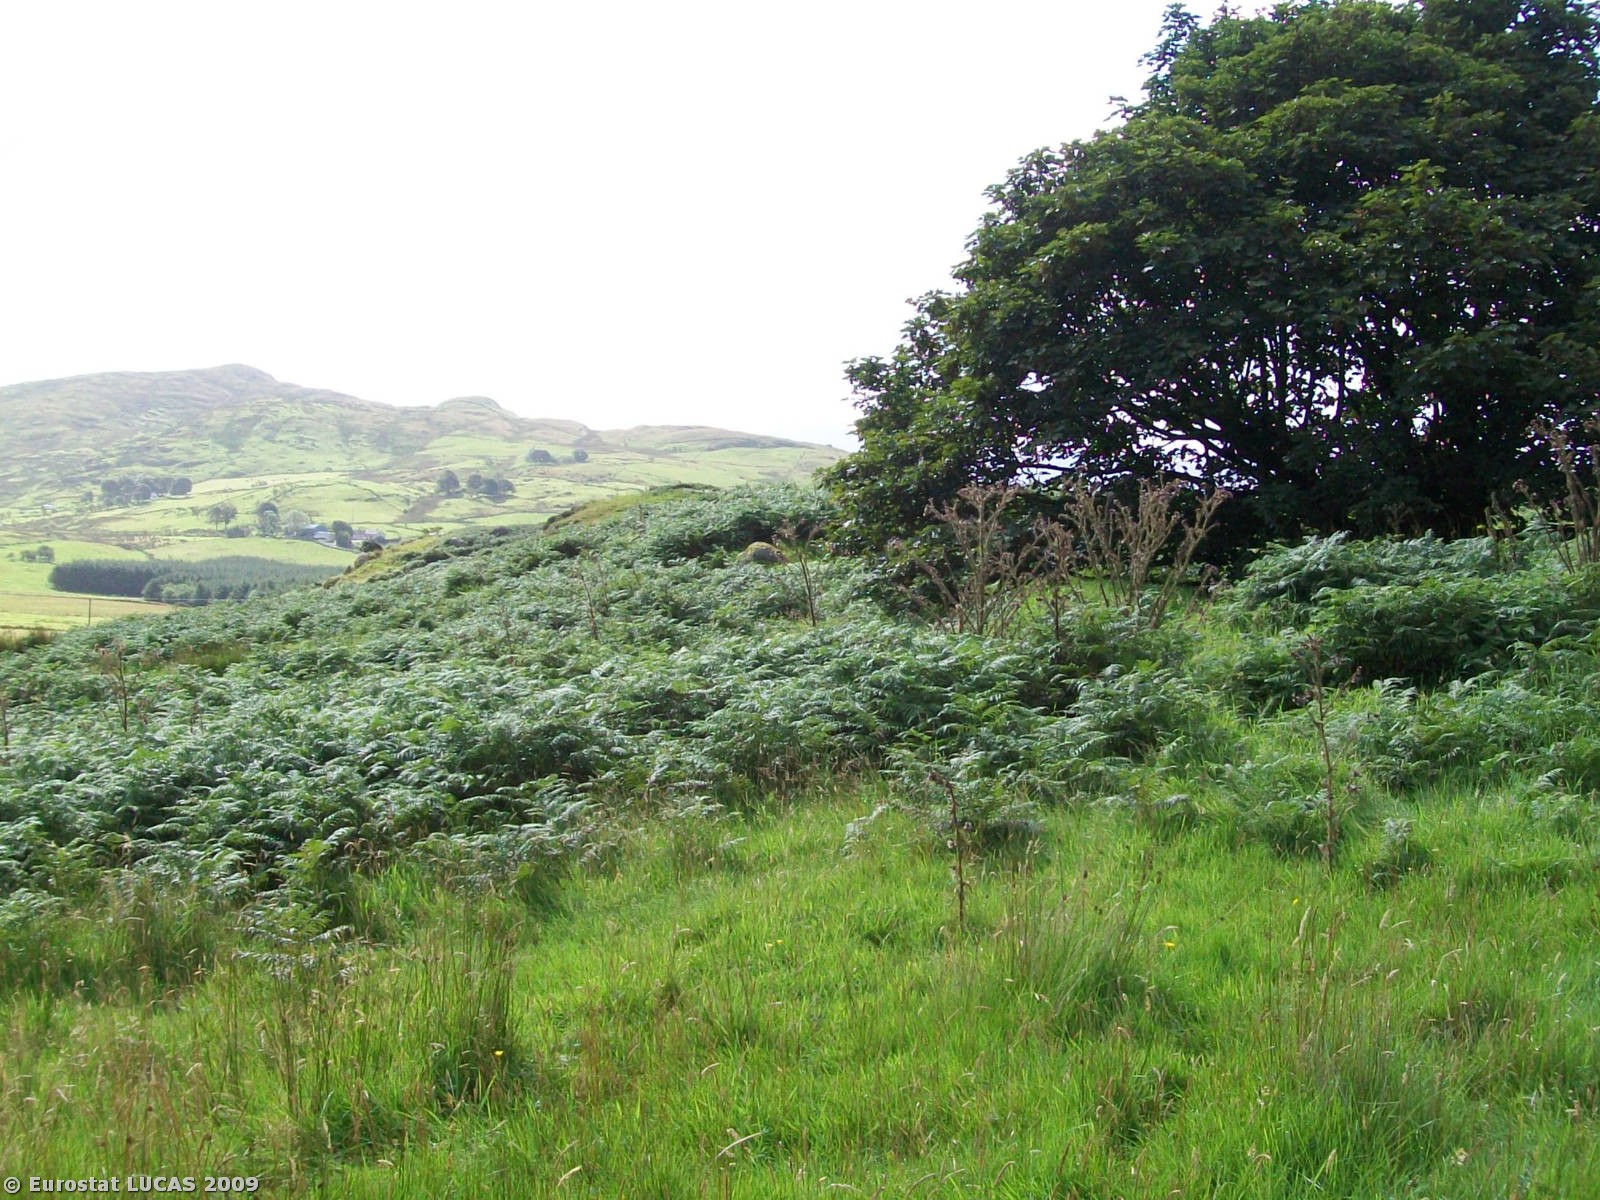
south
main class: Grassland
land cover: Grassland without tree/shrub cover
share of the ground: > 75 %
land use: Agriculture (excluding fallow land and kitchen gardens)
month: August
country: GB
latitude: 54.3296
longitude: -5.9952
